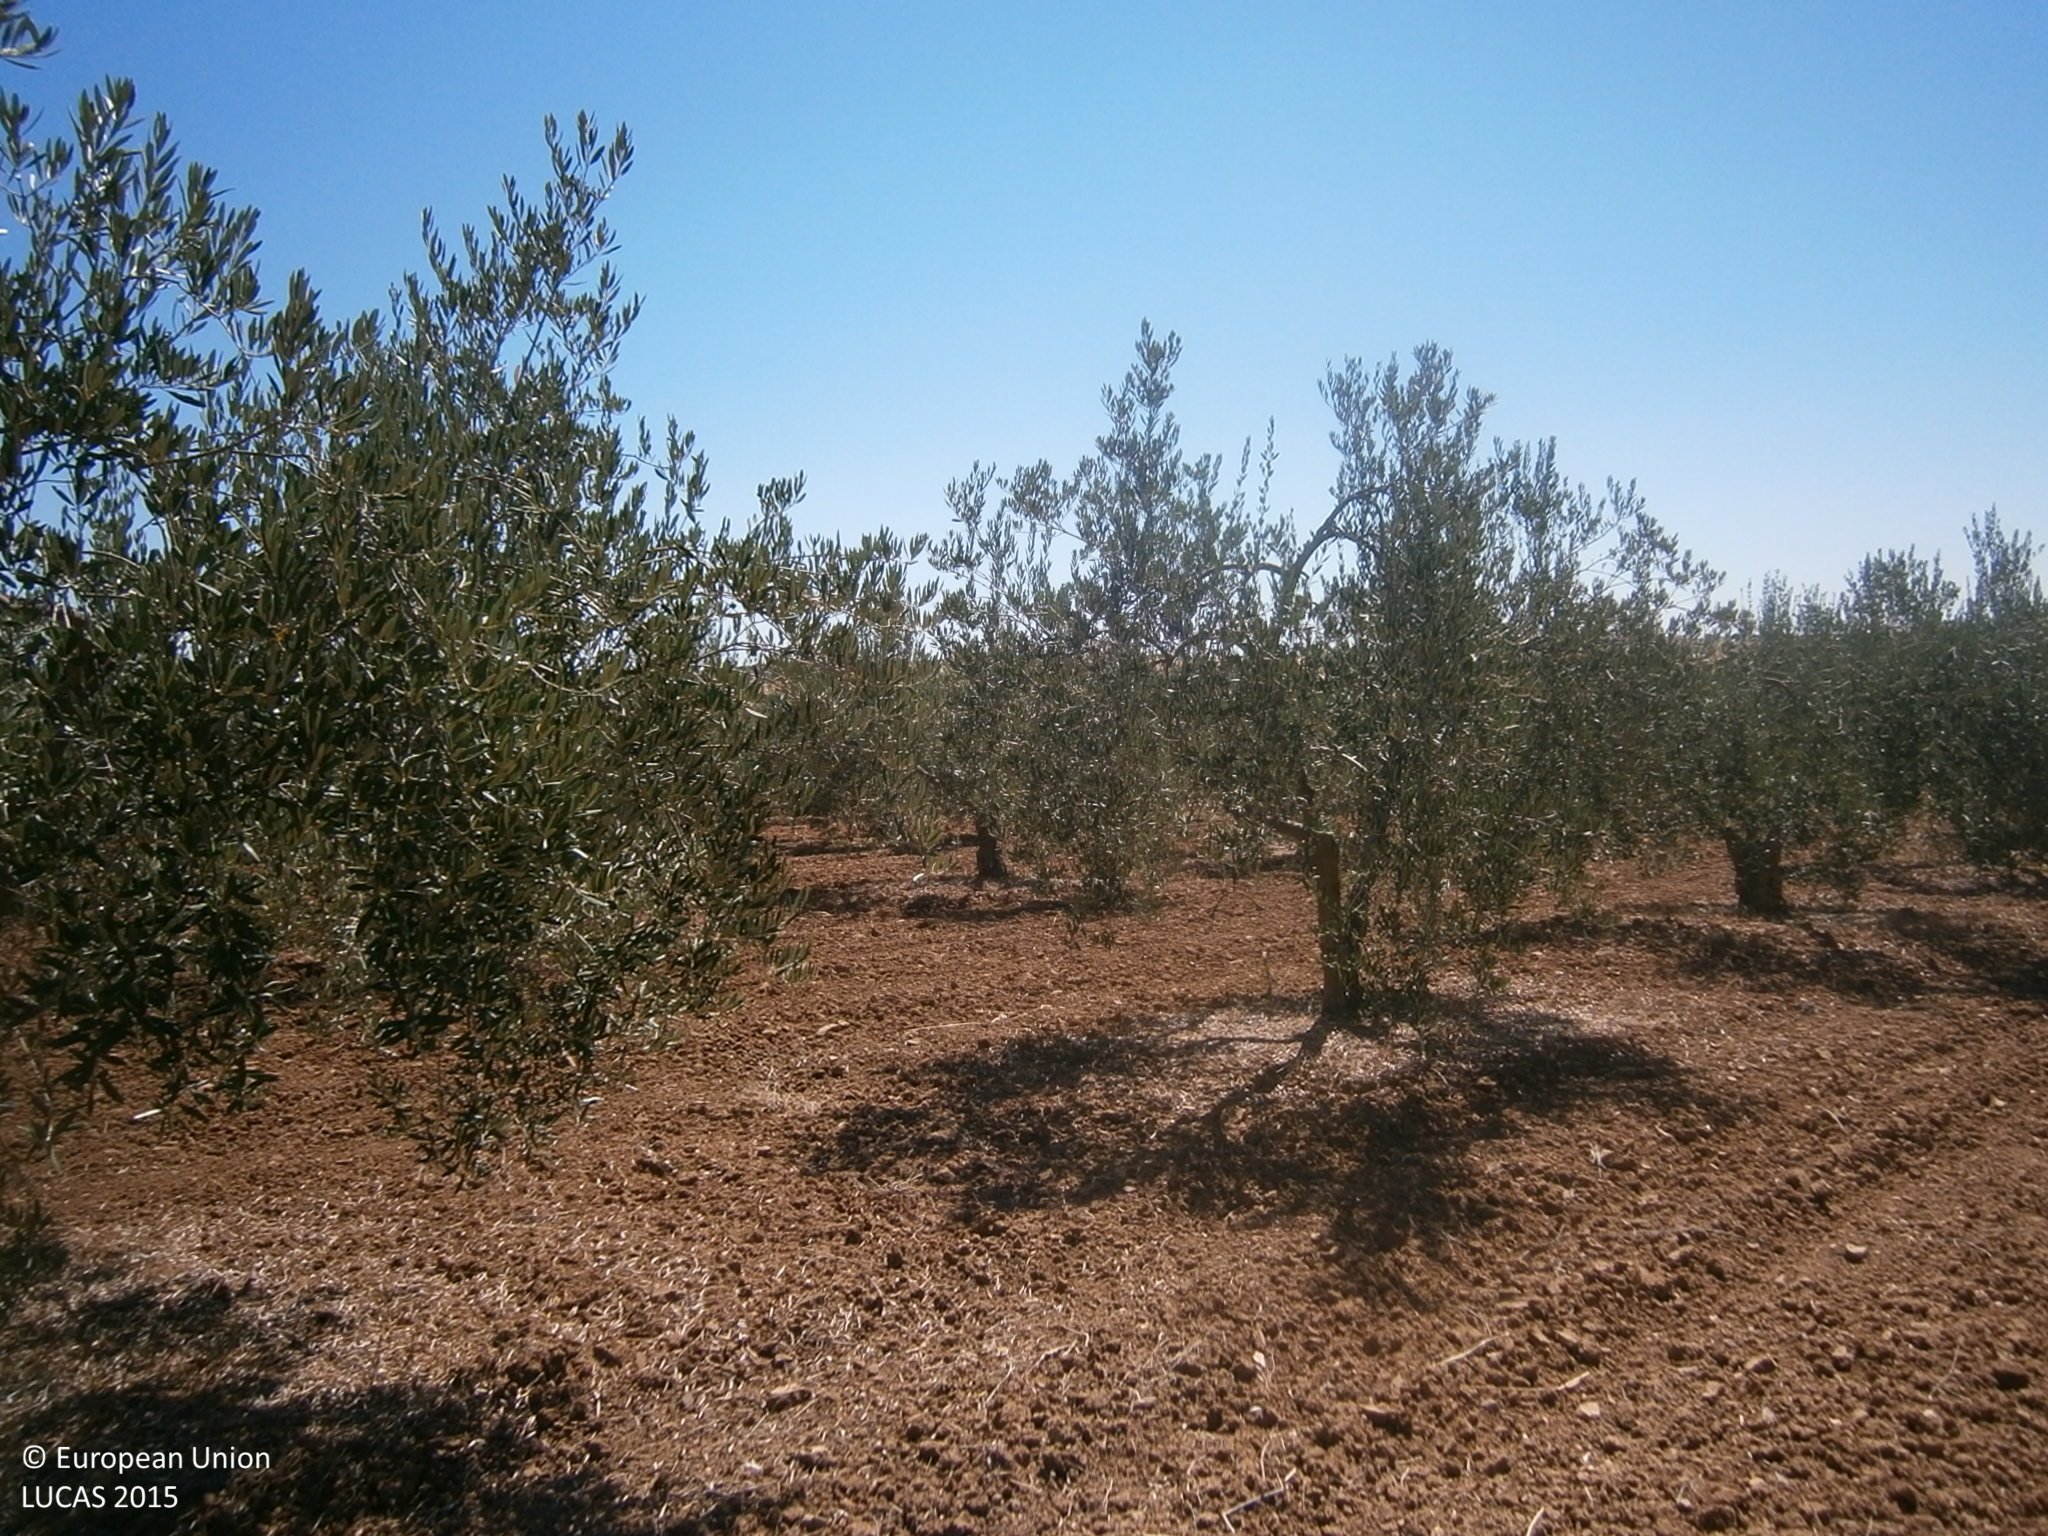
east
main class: Cropland
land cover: Olive groves
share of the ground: 25 - 50 %
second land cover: Other bare soil
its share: > 75 %
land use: Agriculture (excluding fallow land and kitchen gardens)
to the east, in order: Olive groves; Other bare soil; Tracks; Shruby margins; Durum wheat
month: July
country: ES
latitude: 38.9165
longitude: -7.0137
